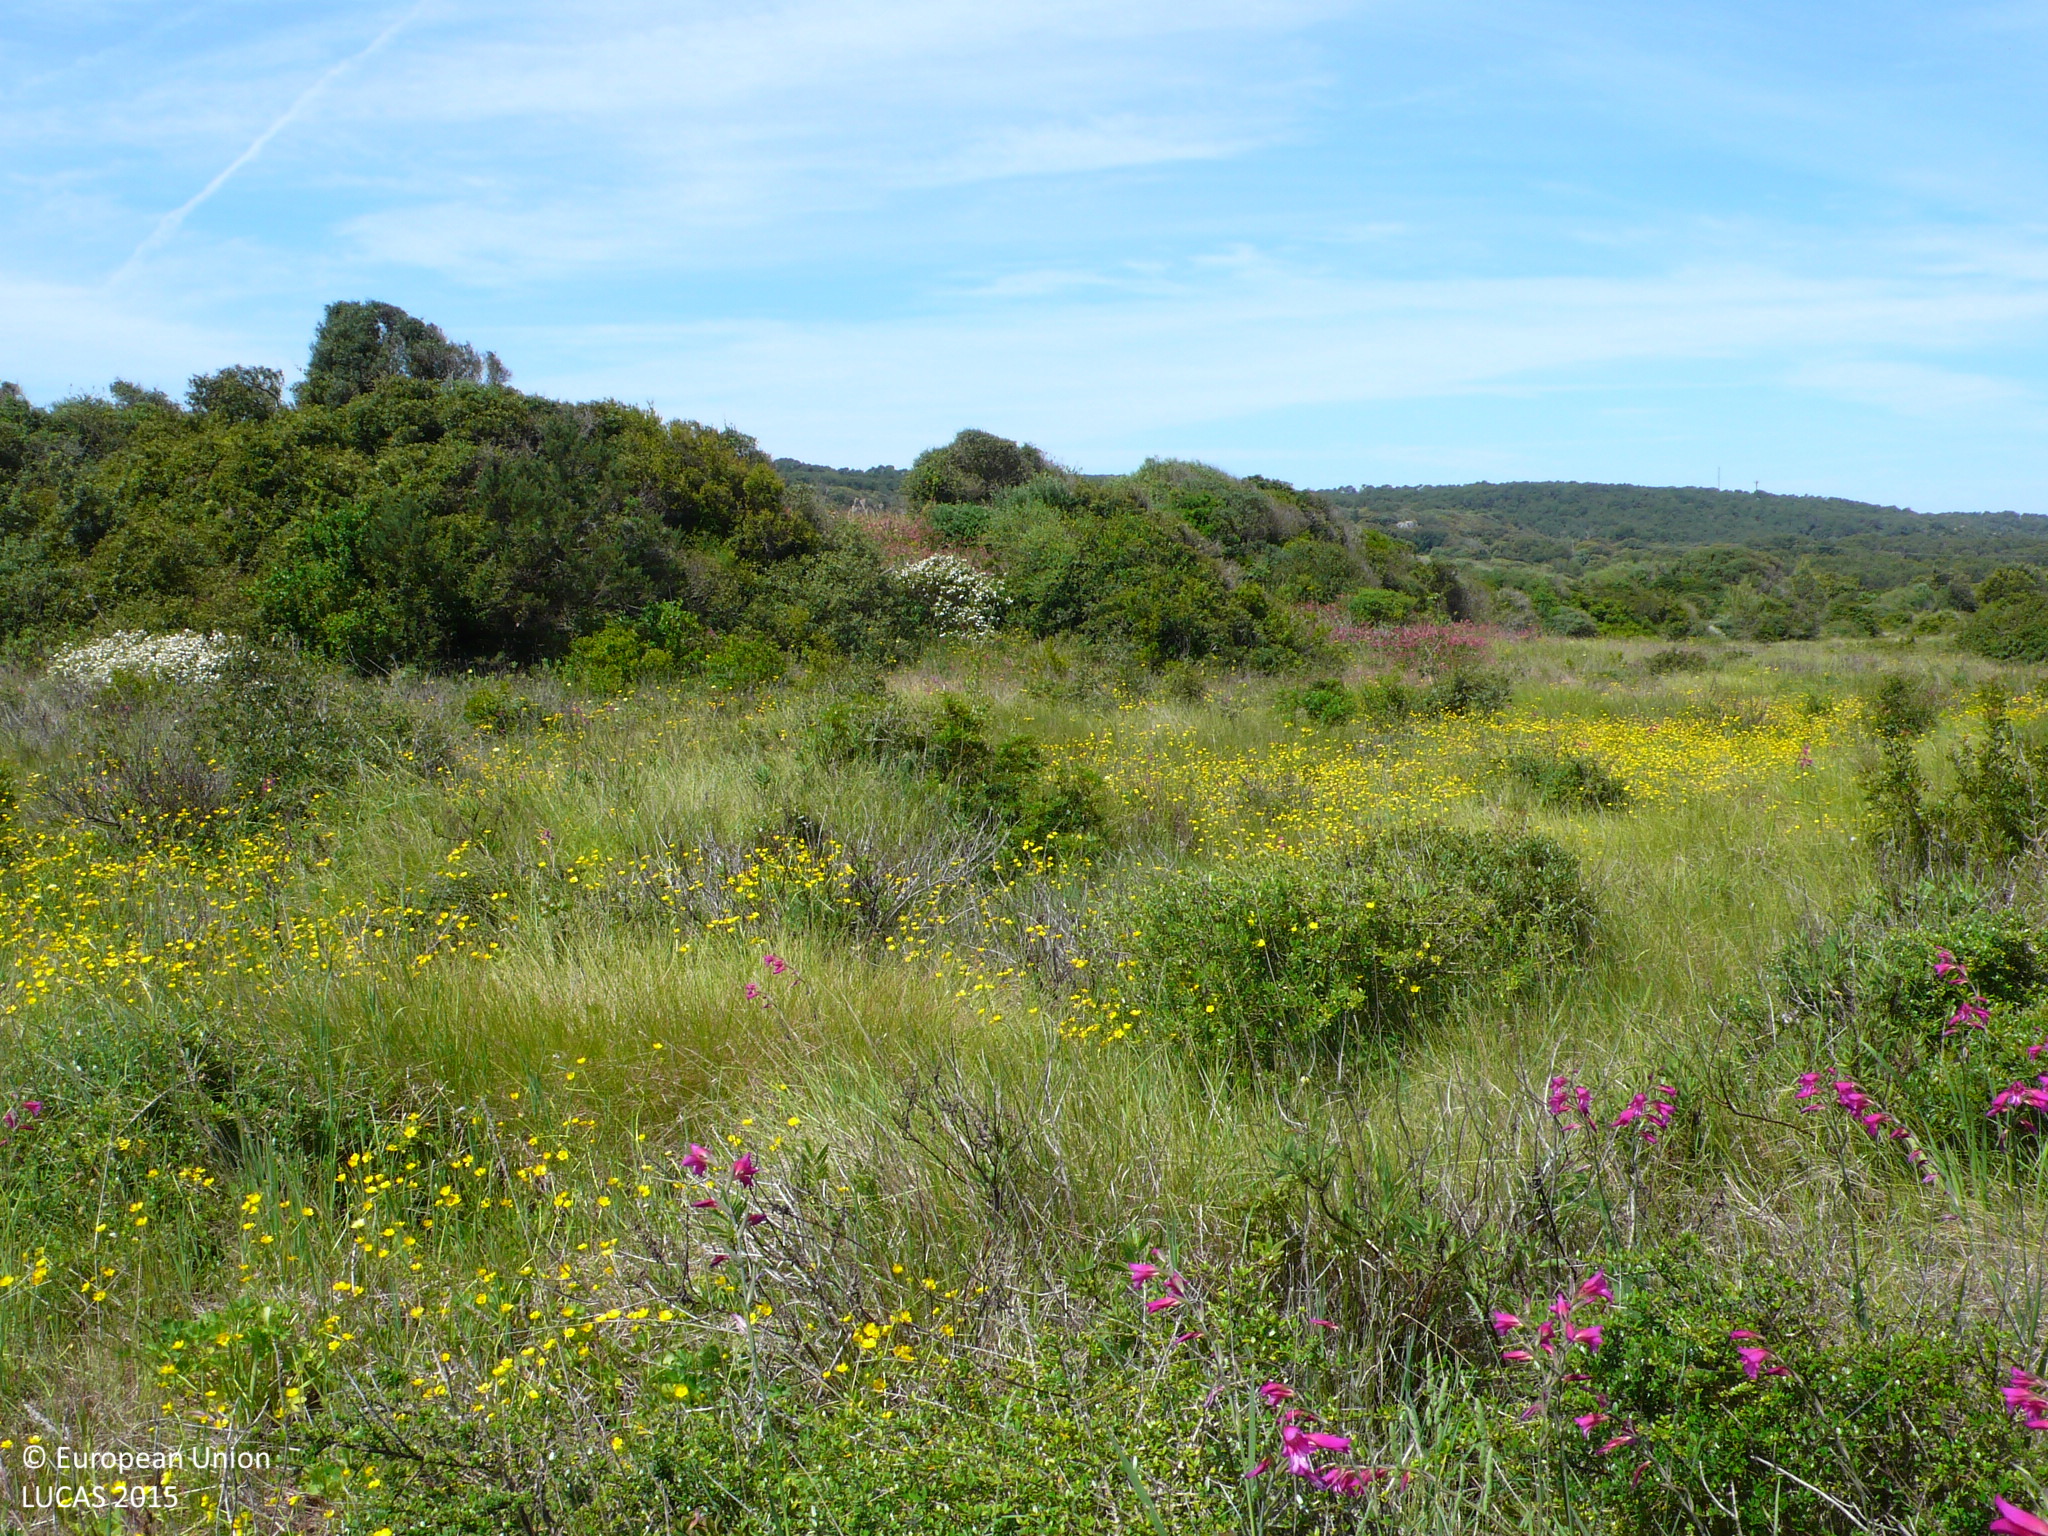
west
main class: Shrubland
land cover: Shrubland with sparse tree cover
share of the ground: 50 - 75 %
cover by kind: shrubs 55 %, herbaceous plants 40 %, broadleaved forest trees 5 %
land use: Semi-natural and natural areas not in use
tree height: < 5 m
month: May
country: ES
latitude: 40.0038
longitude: 4.1804
